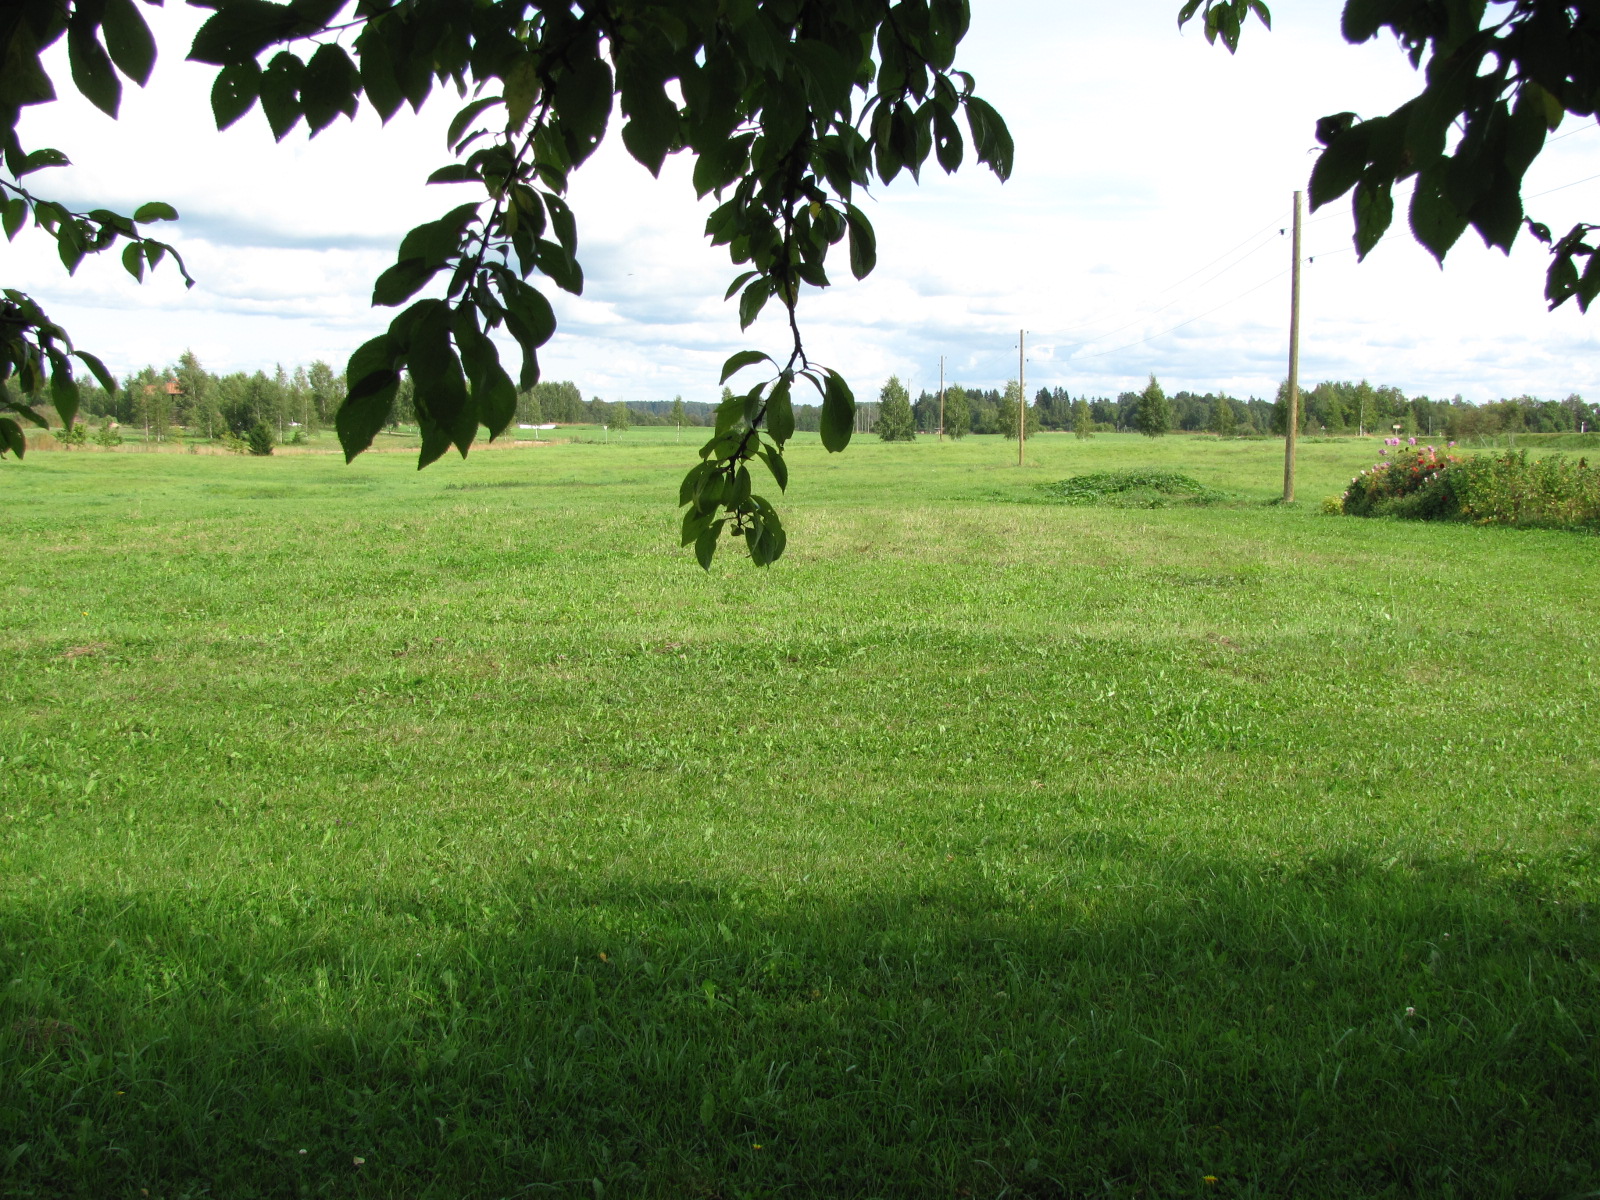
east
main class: Cropland
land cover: Apple fruit
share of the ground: 25 - 50 %
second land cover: Grassland without tree/shrub cover
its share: > 75 %
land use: Kitchen garden
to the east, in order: Apple fruit; Grassland without tree/shrub cover; Fences; Grassland without tree/shrub cover; Tracks; Lines of trees
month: August
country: LV
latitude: 56.8853
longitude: 25.2270
